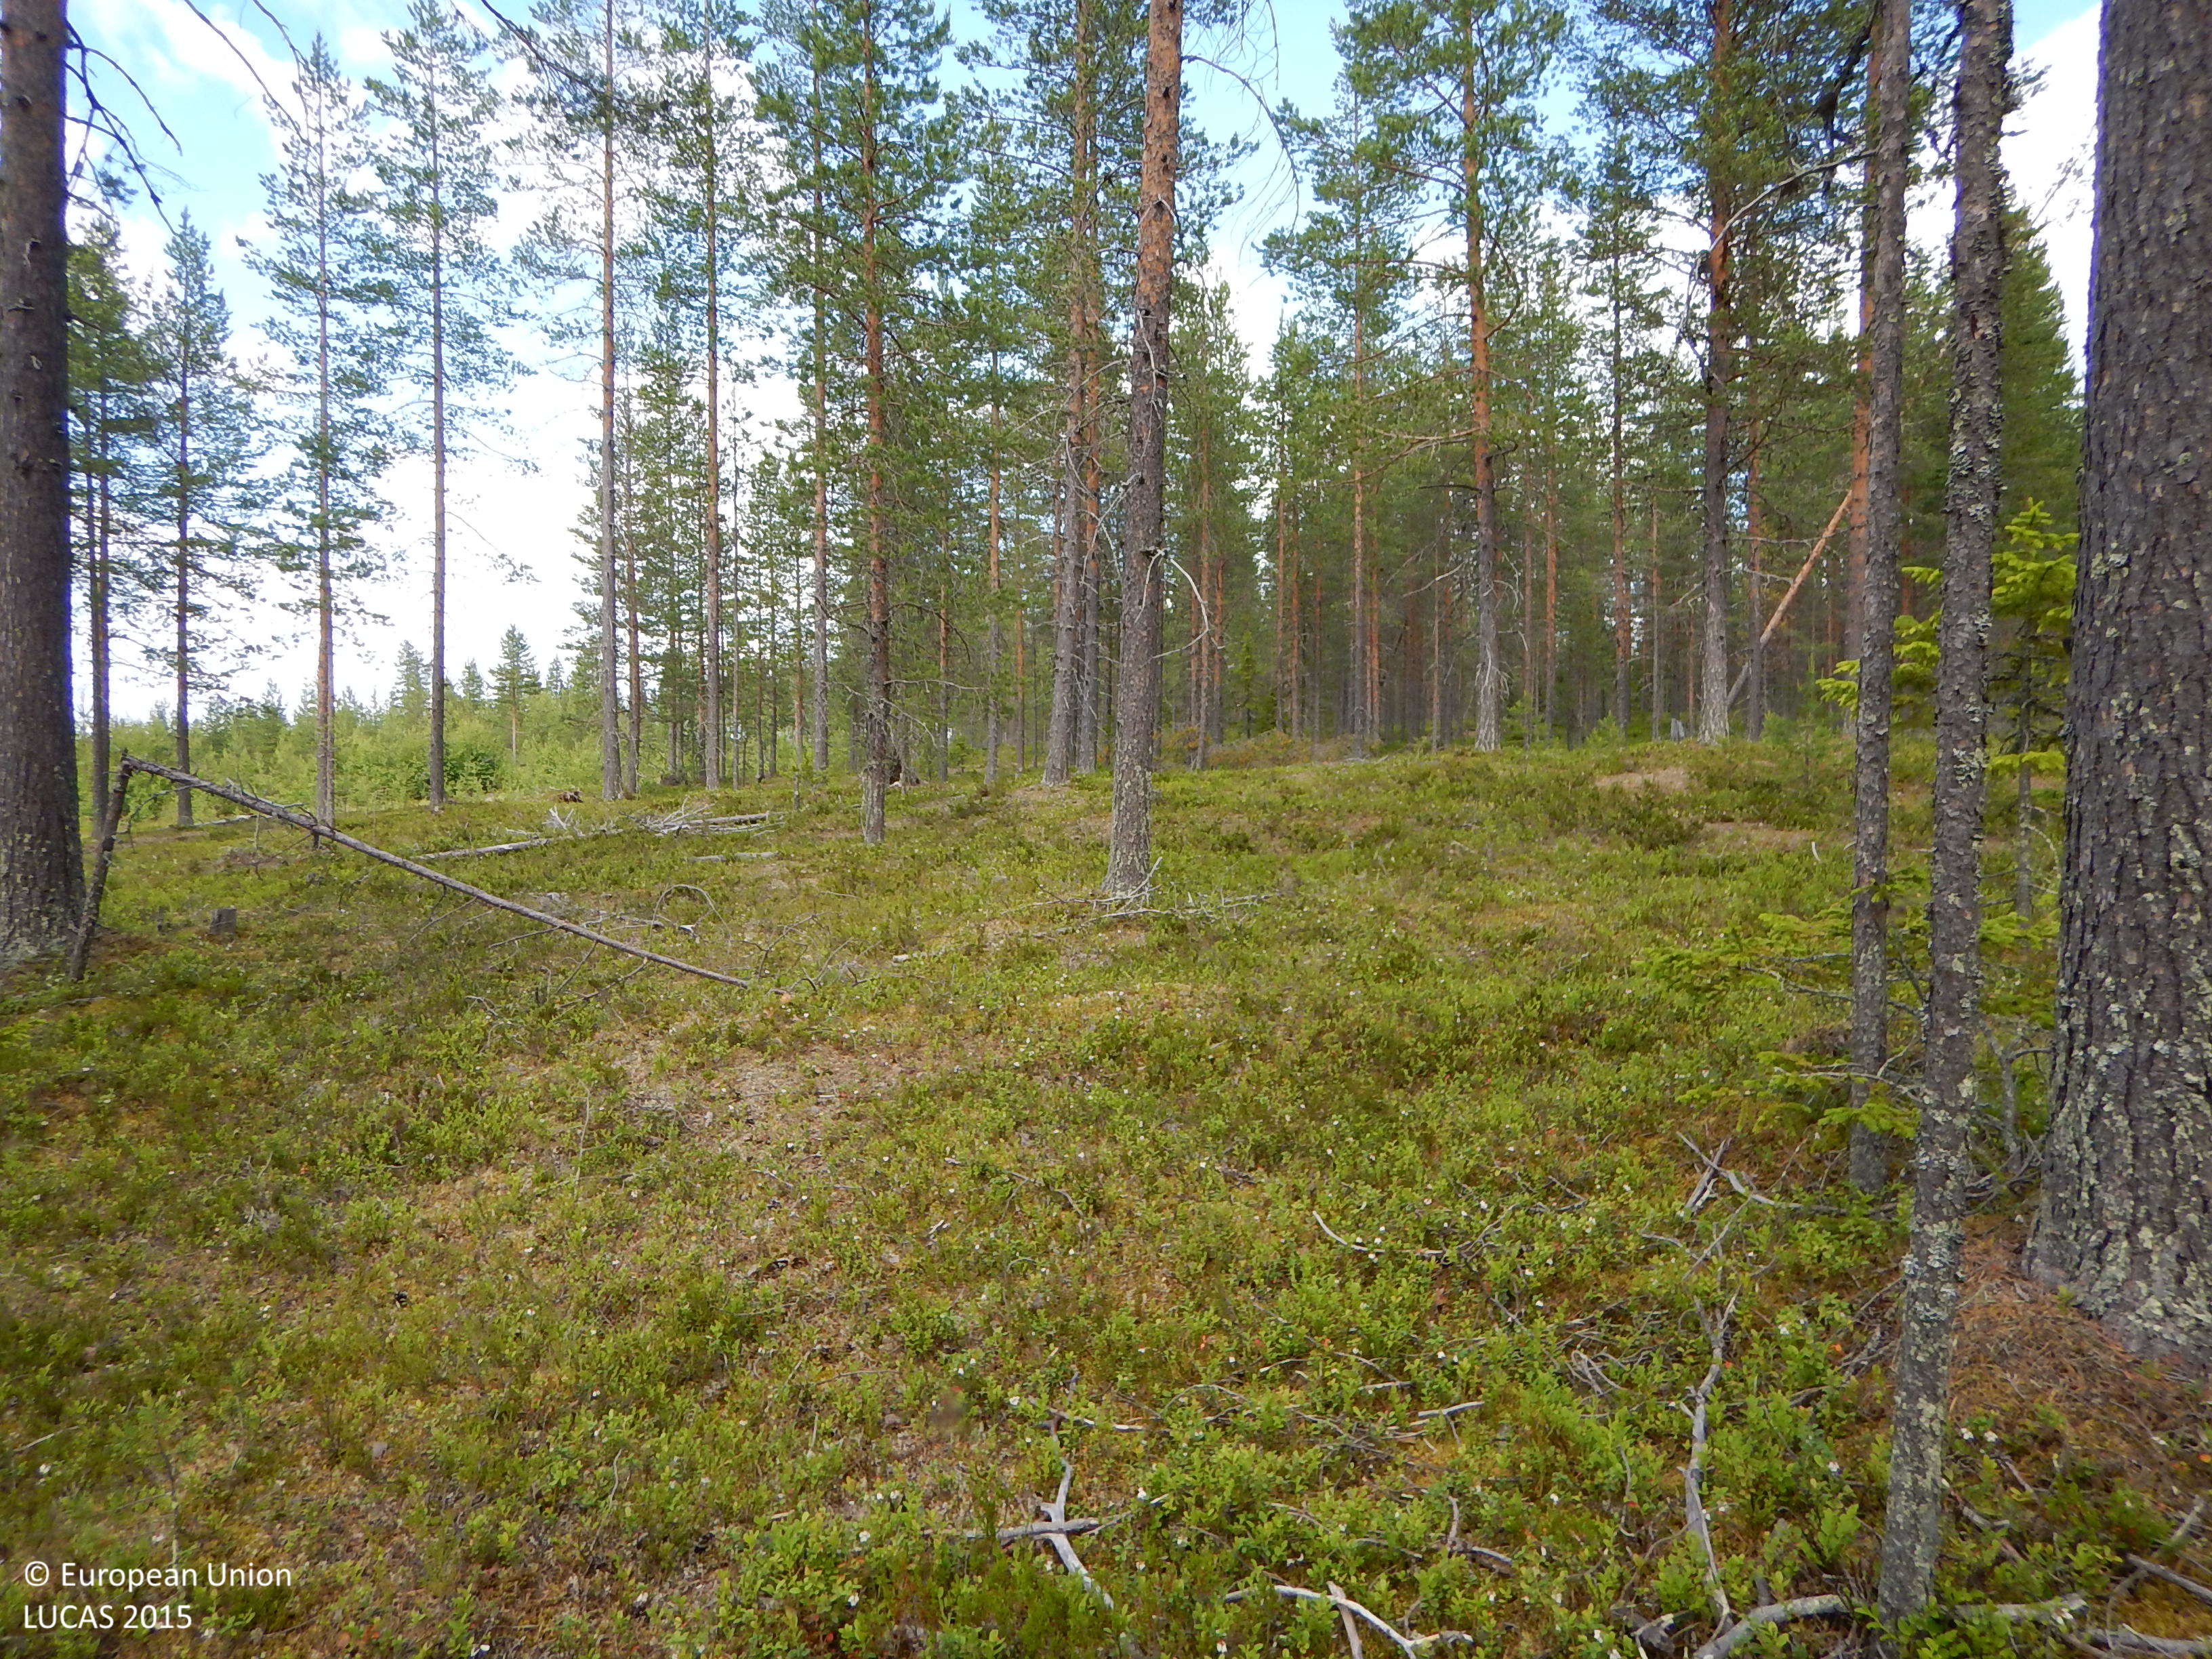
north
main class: Woodland
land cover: Pine dominated coniferous woodland
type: boreal forest
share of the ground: 50 - 75 %
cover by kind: coniferous forest trees 50 %, lichens and mosses 20 %, shrubs 15 %, herbaceous plants 15 %
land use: Forestry
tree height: > 5 m
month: July
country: SE
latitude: 65.0346
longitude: 19.9275
